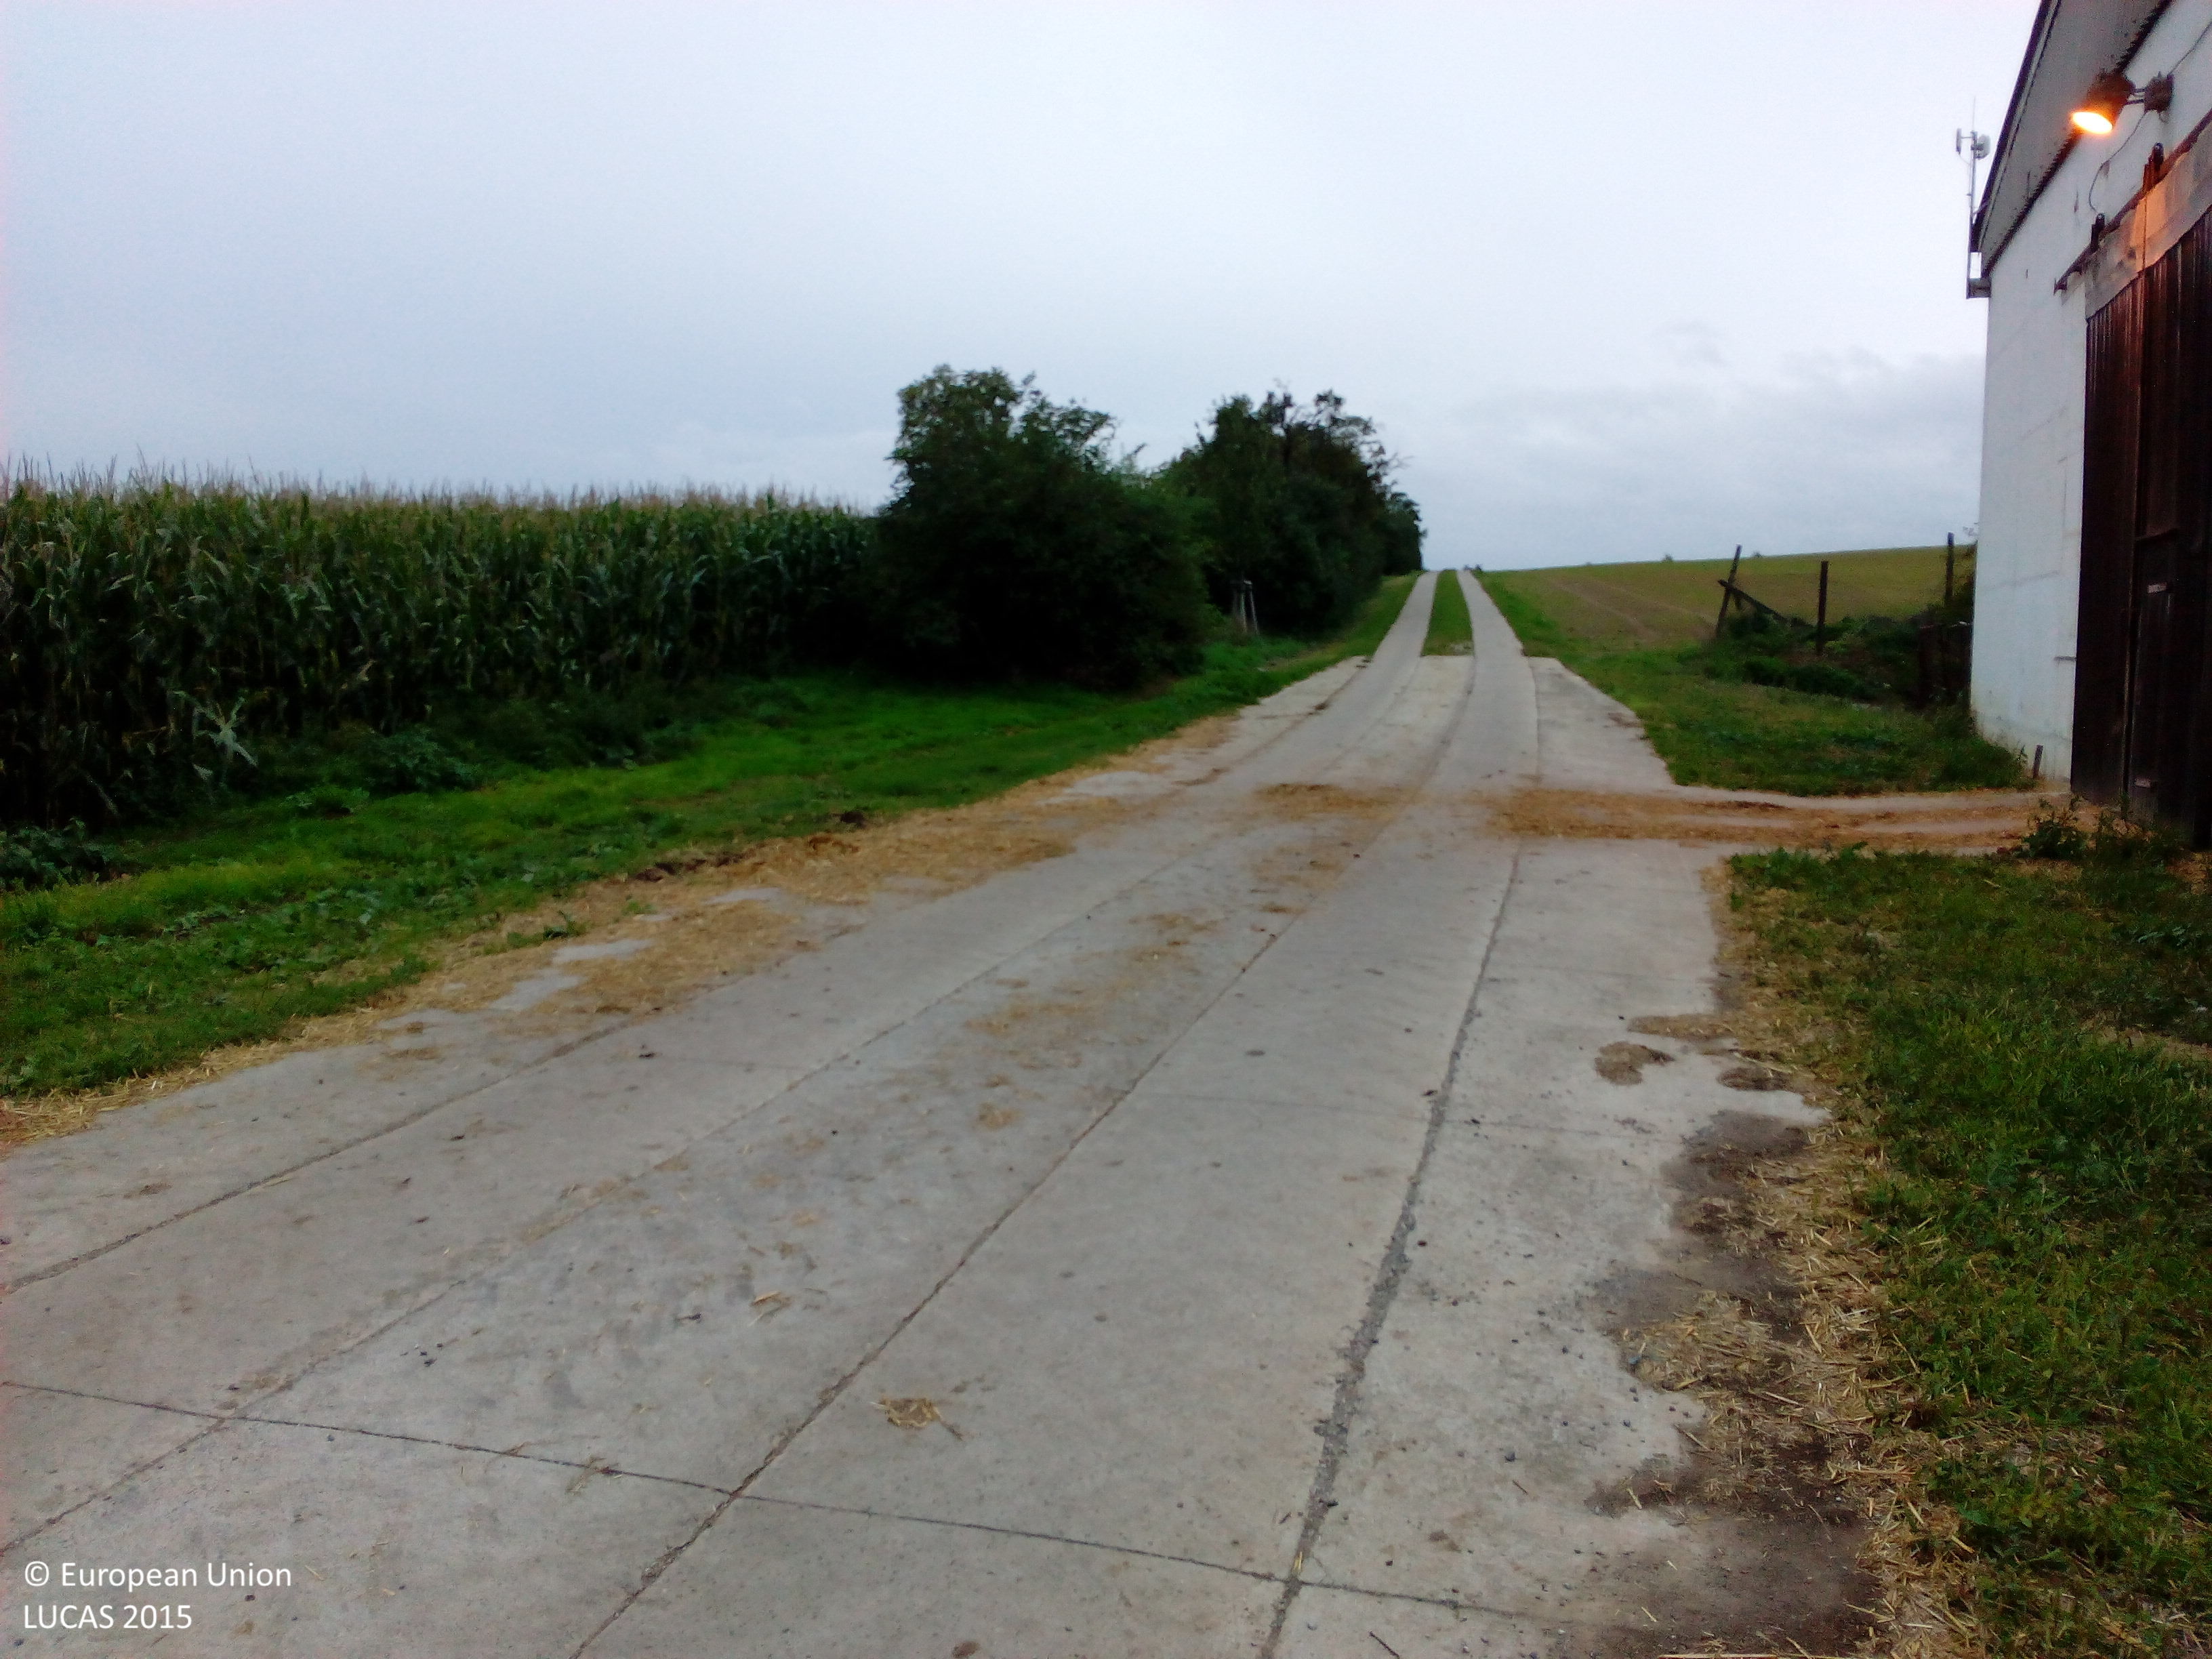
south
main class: Shrubland
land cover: Shrubland without tree cover
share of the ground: > 75 %
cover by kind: shrubs 90 %, herbaceous plants 10 %
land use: Semi-natural and natural areas not in use
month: September
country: DE
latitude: 51.8158
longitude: 11.0296
